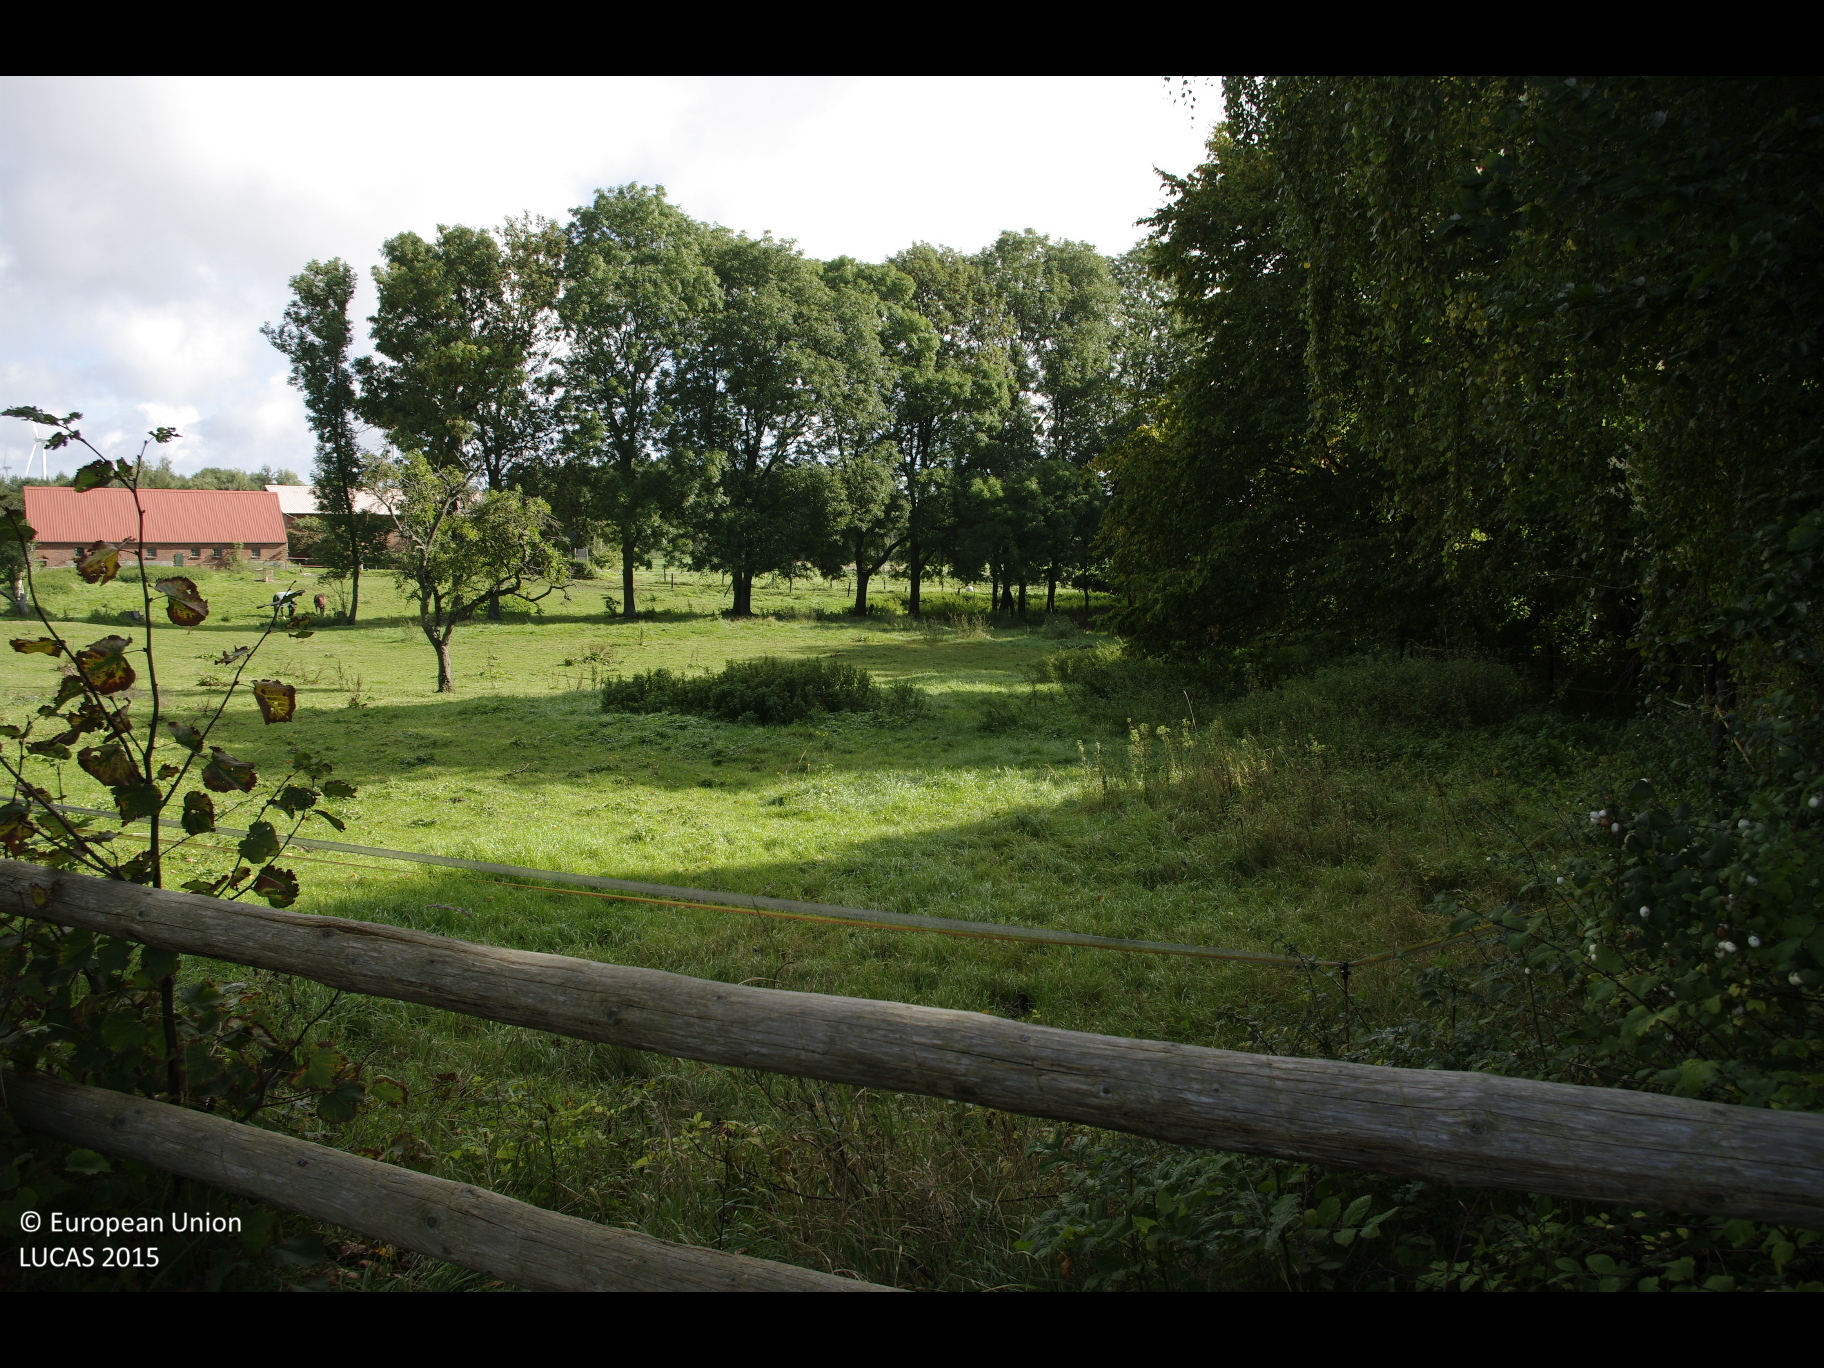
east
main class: Woodland
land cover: Other mixed woodland
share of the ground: > 75 %
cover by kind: coniferous forest trees 50 %, broadleaved forest trees 40 %, shrubs 10 %
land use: Residential
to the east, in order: Other mixed woodland; Broadleaved woodland; Fences; Grassland without tree/shrub cover; Broadleaved woodland; Fences; Tracks; Fences; Grassland without tree/shrub cover; Fences; Grass margins; Rape and turnip rape; Electric lines; Rape and turnip rape
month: September
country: DE
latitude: 53.9934
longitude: 10.6250
